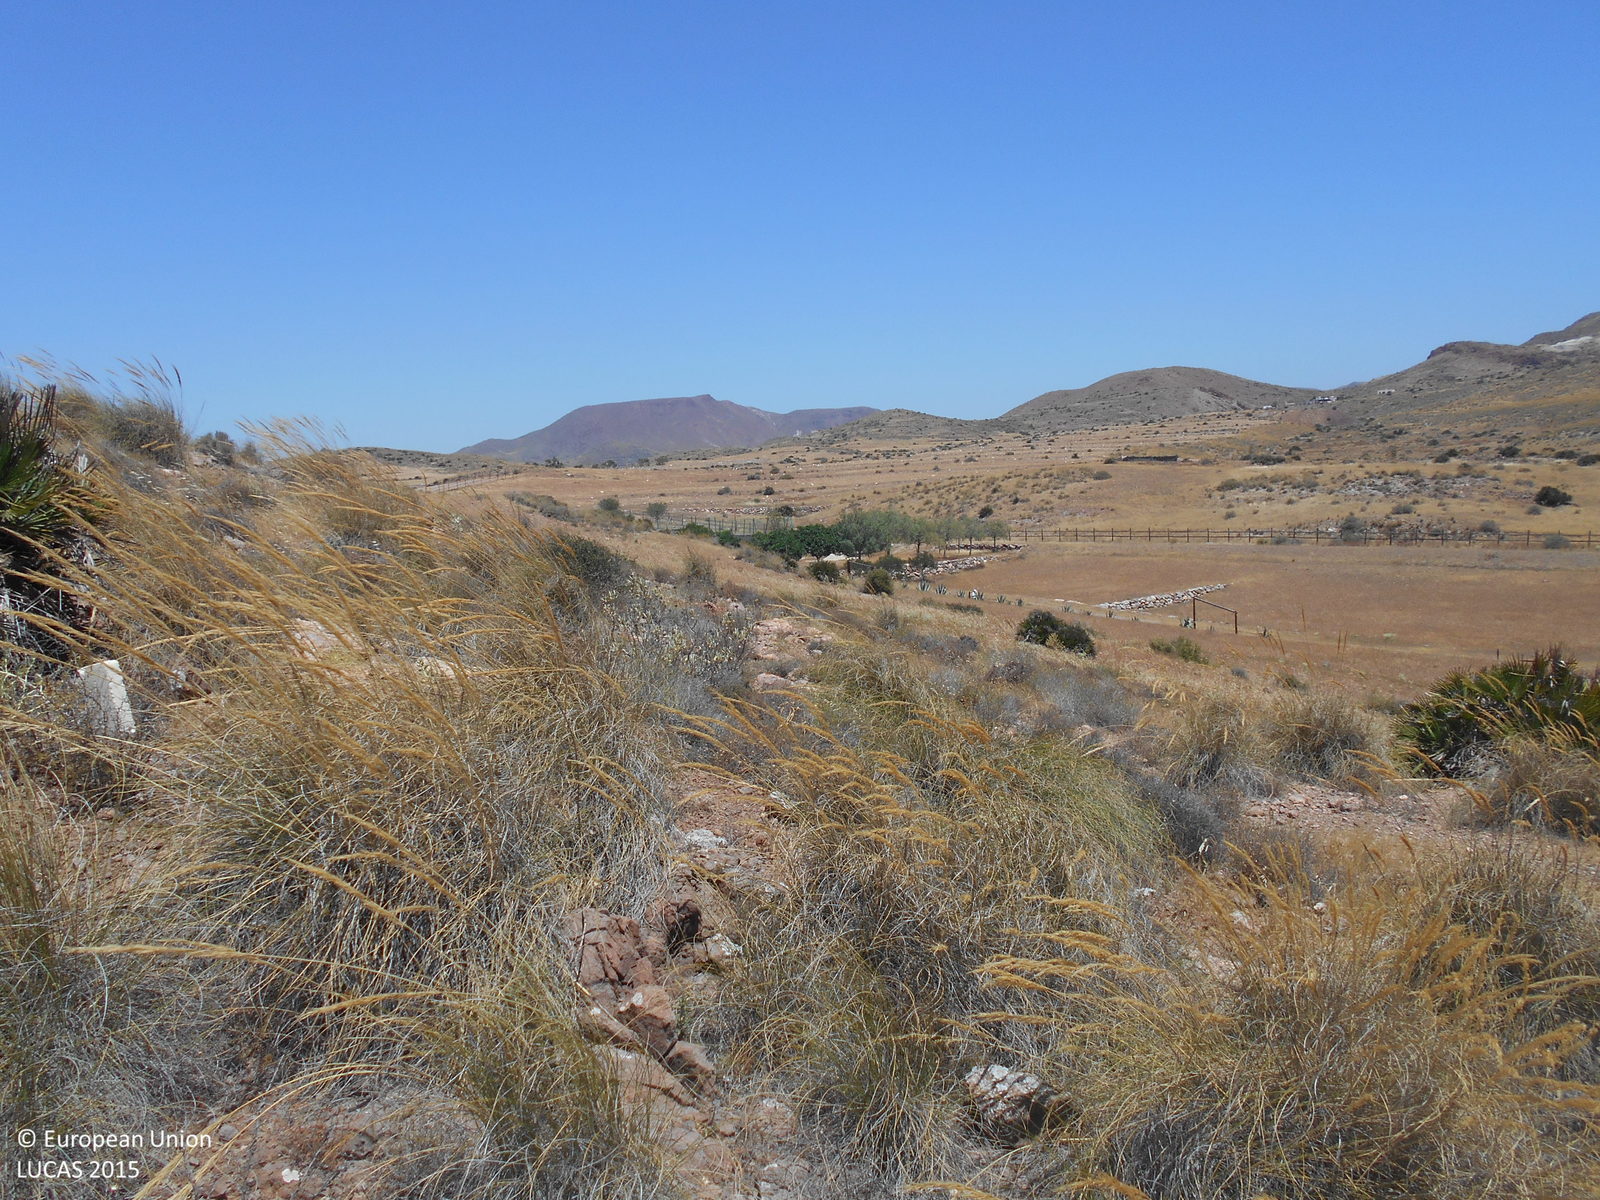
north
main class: Shrubland
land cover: Shrubland without tree cover
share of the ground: 50 - 75 %
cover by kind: shrubs 70 %, herbaceous plants 10 %, consolidated bare surface 10 %, unconsolidated bare surface 10 %
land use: Semi-natural and natural areas not in use
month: May
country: ES
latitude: 36.7696
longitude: -2.1053
